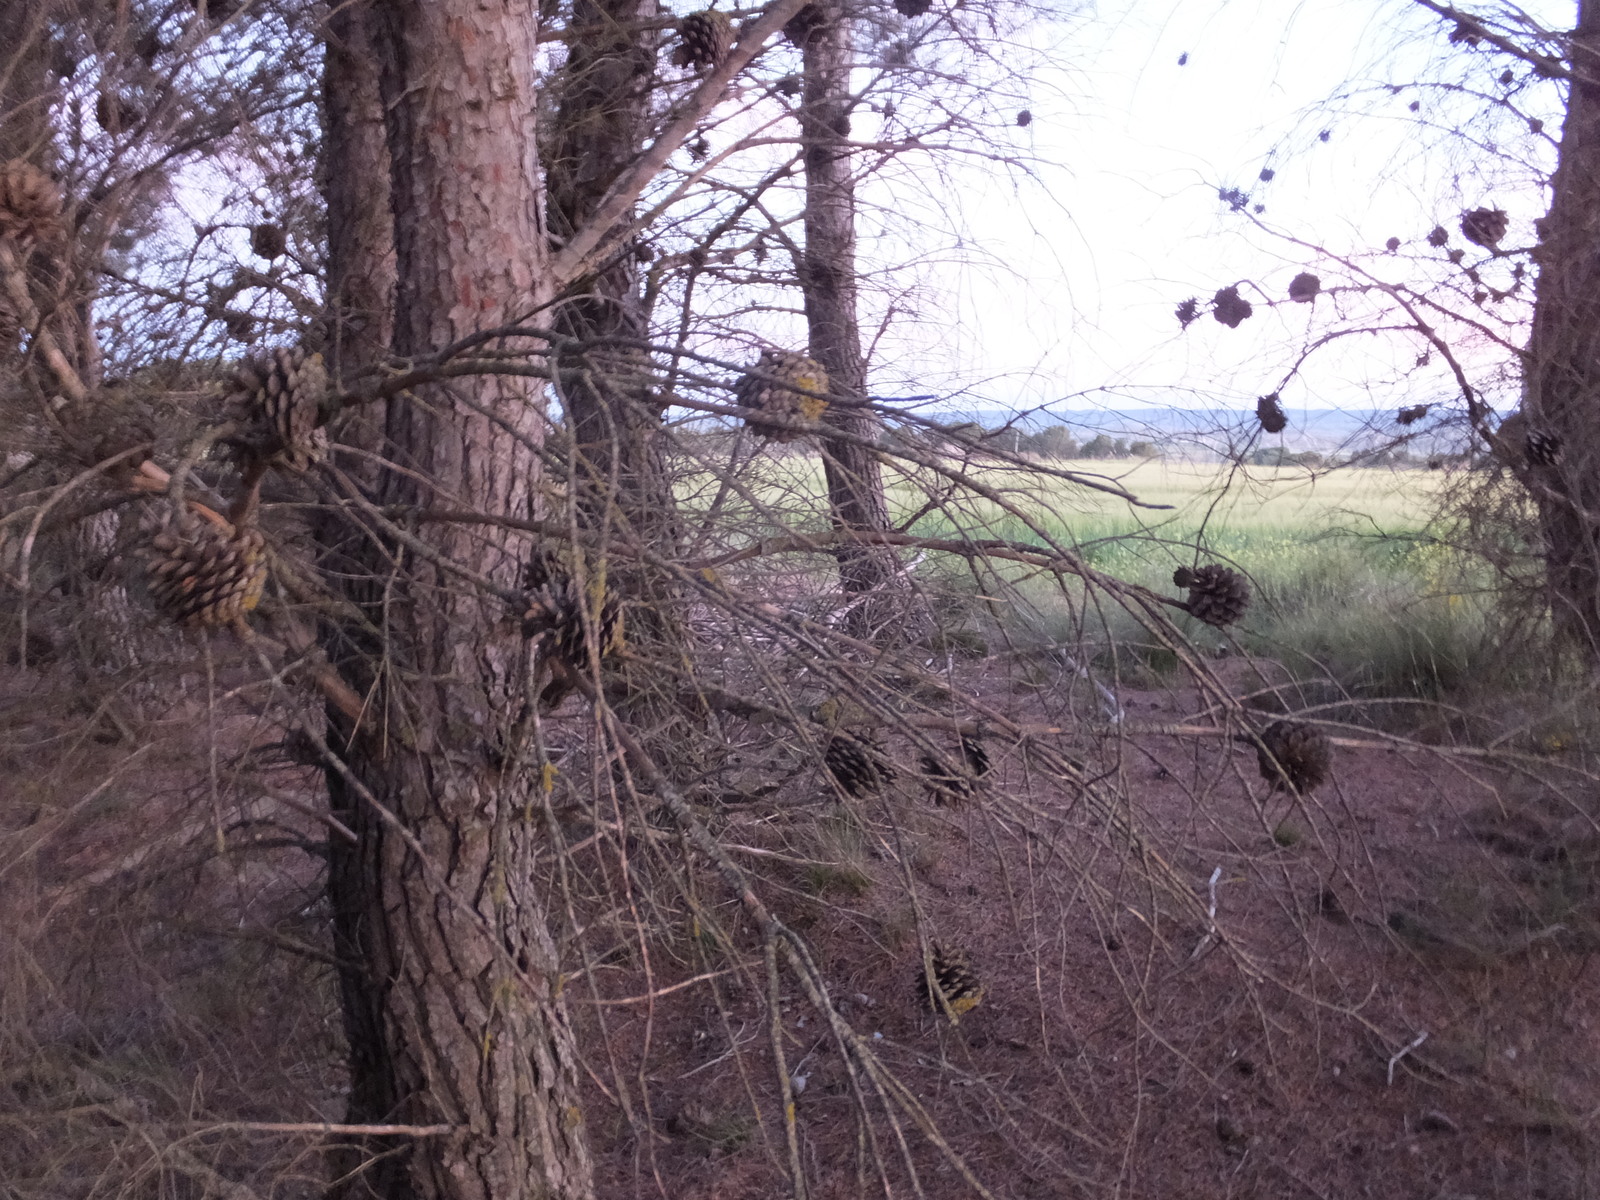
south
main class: Woodland
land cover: Pine dominated coniferous woodland
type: coniferous forest of the mediterranean region
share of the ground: 50 - 75 %
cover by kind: coniferous forest trees 75 %, herbaceous plants 25 %
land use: Forestry
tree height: > 5 m
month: April
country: ES
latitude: 41.7528
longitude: -0.2285
